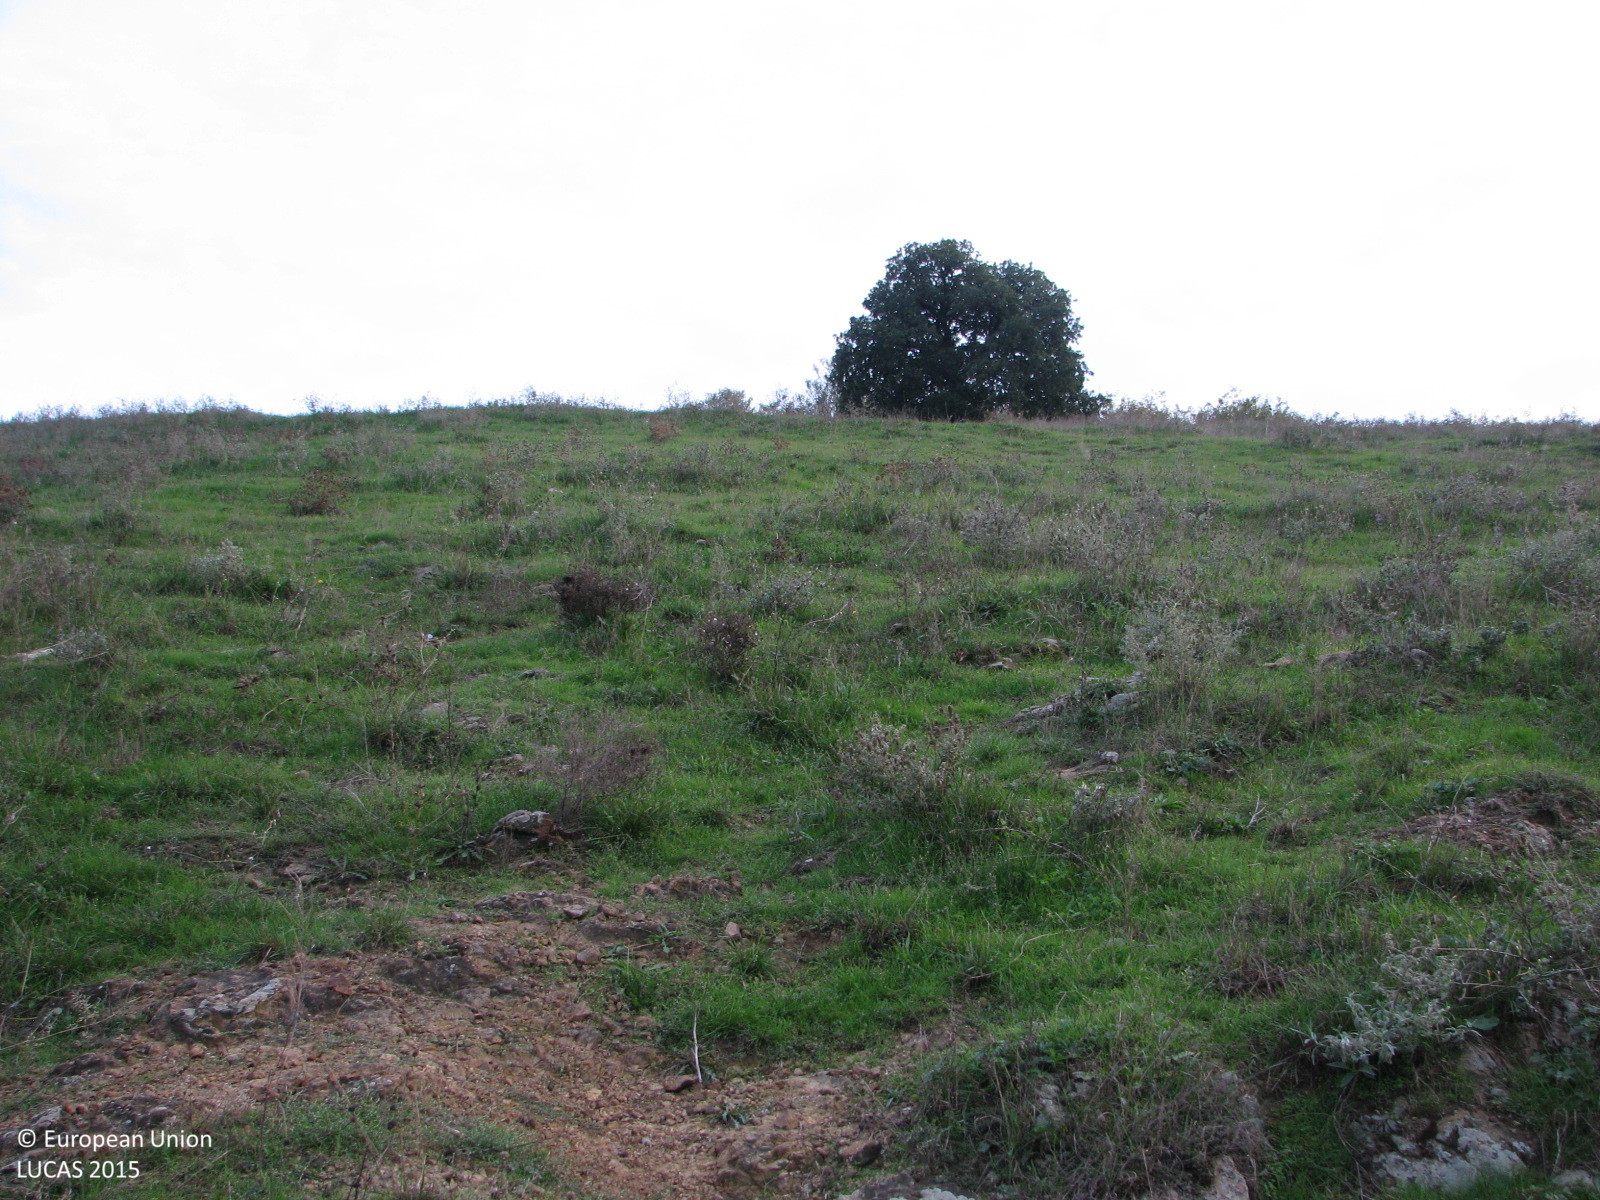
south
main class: Grassland
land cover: Grassland without tree/shrub cover
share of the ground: > 75 %
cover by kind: herbaceous plants 85 %, unconsolidated bare surface 15 %
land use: Agriculture (excluding fallow land and kitchen gardens)
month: October
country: BG
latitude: 42.2445
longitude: 26.5109
